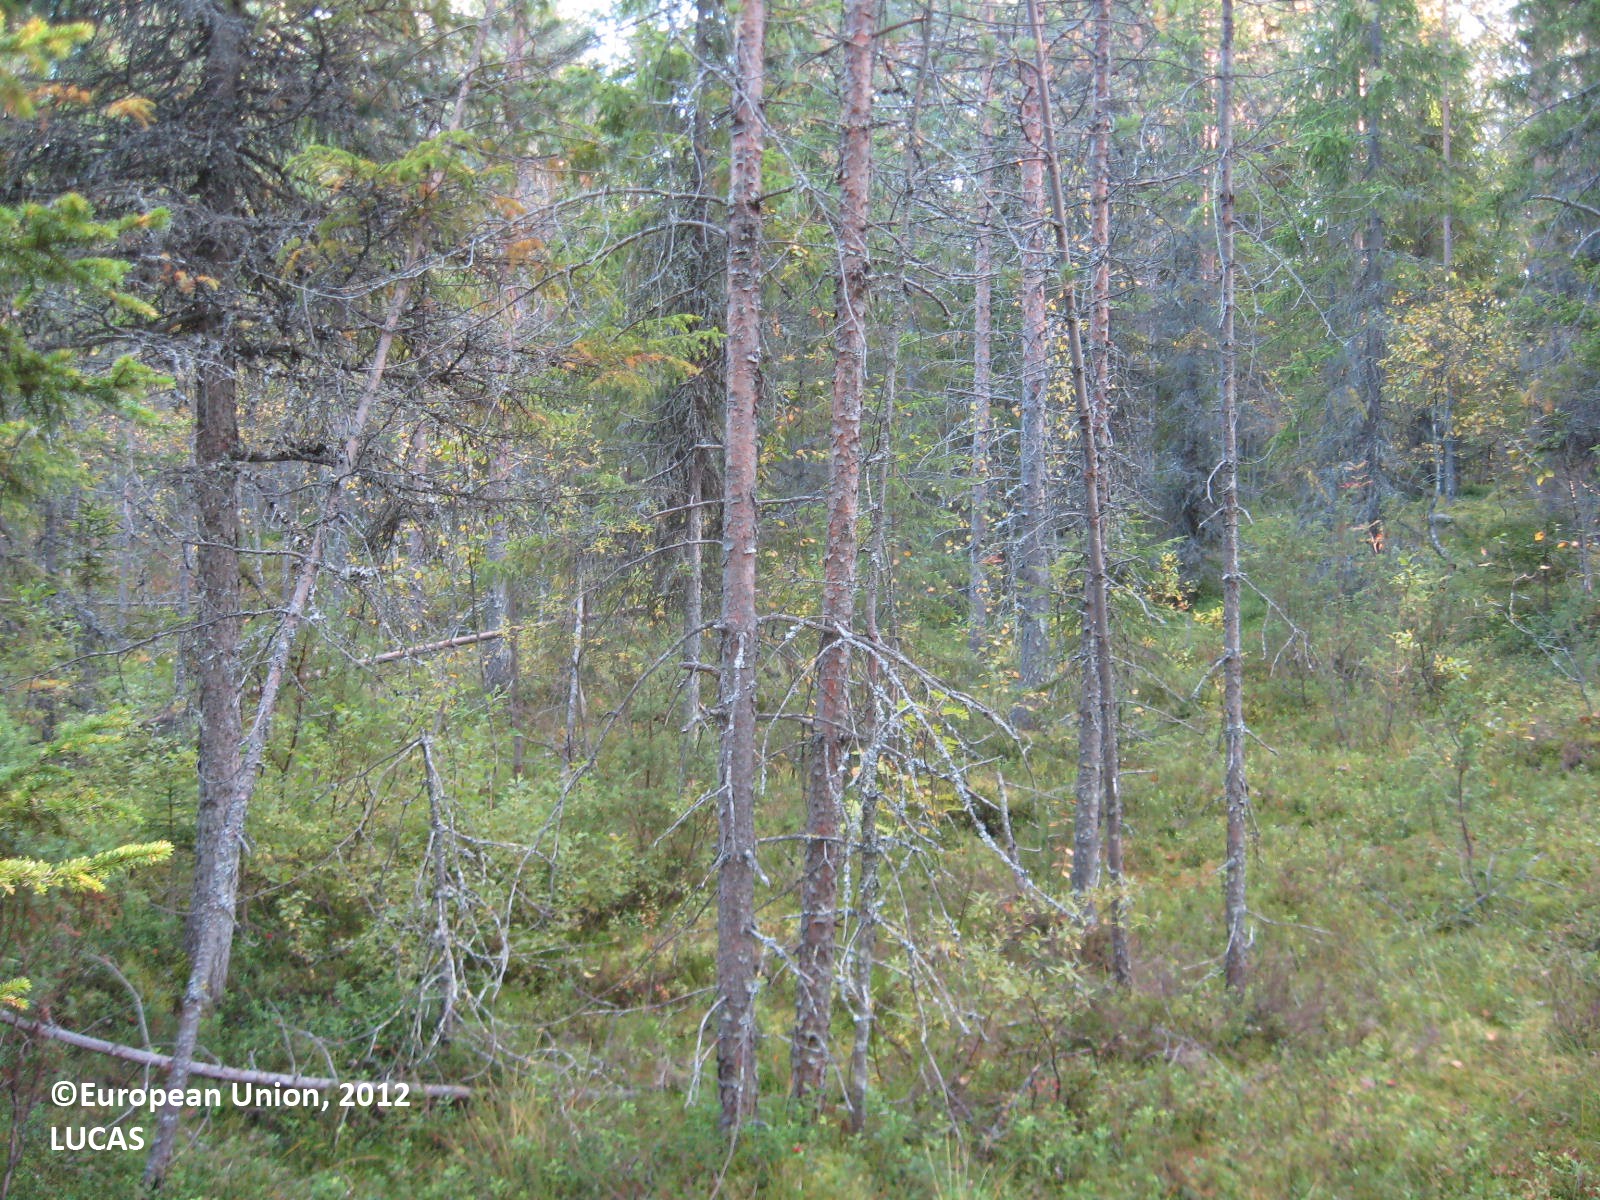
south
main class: Woodland
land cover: Pine dominated coniferous woodland
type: boreal forest
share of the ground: > 75 %
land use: Forestry
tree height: > 5 m
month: August
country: FI
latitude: 63.9506
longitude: 29.6790
